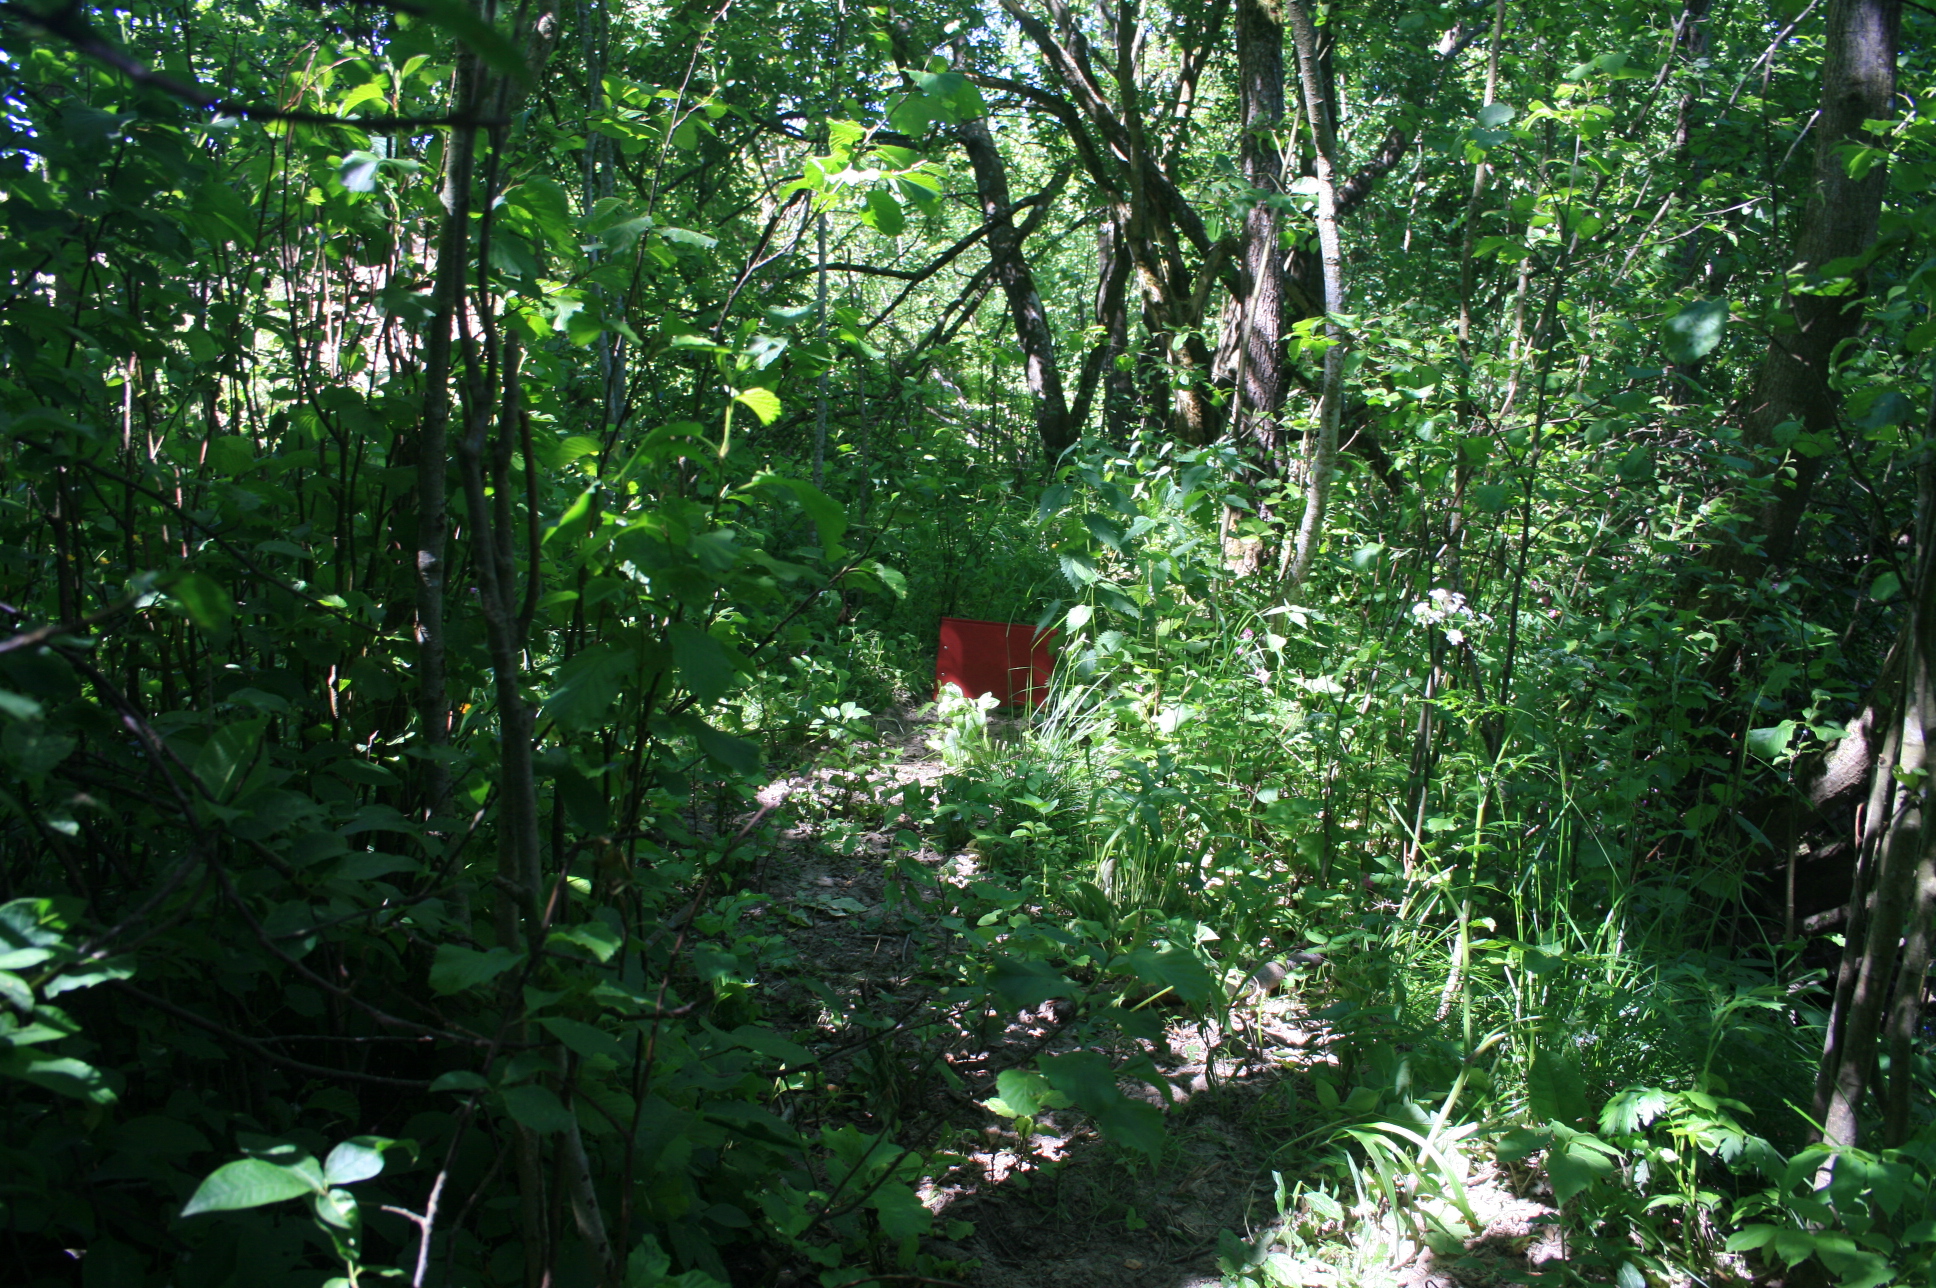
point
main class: Woodland
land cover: Broadleaved woodland
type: floodplain forest
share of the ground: > 75 %
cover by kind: broadleaved forest trees 90 %, herbaceous plants 5 %, unconsolidated bare surface 5 %
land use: Semi-natural and natural areas not in use
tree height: > 5 m
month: June
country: LT
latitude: 55.5532
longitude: 22.1503
